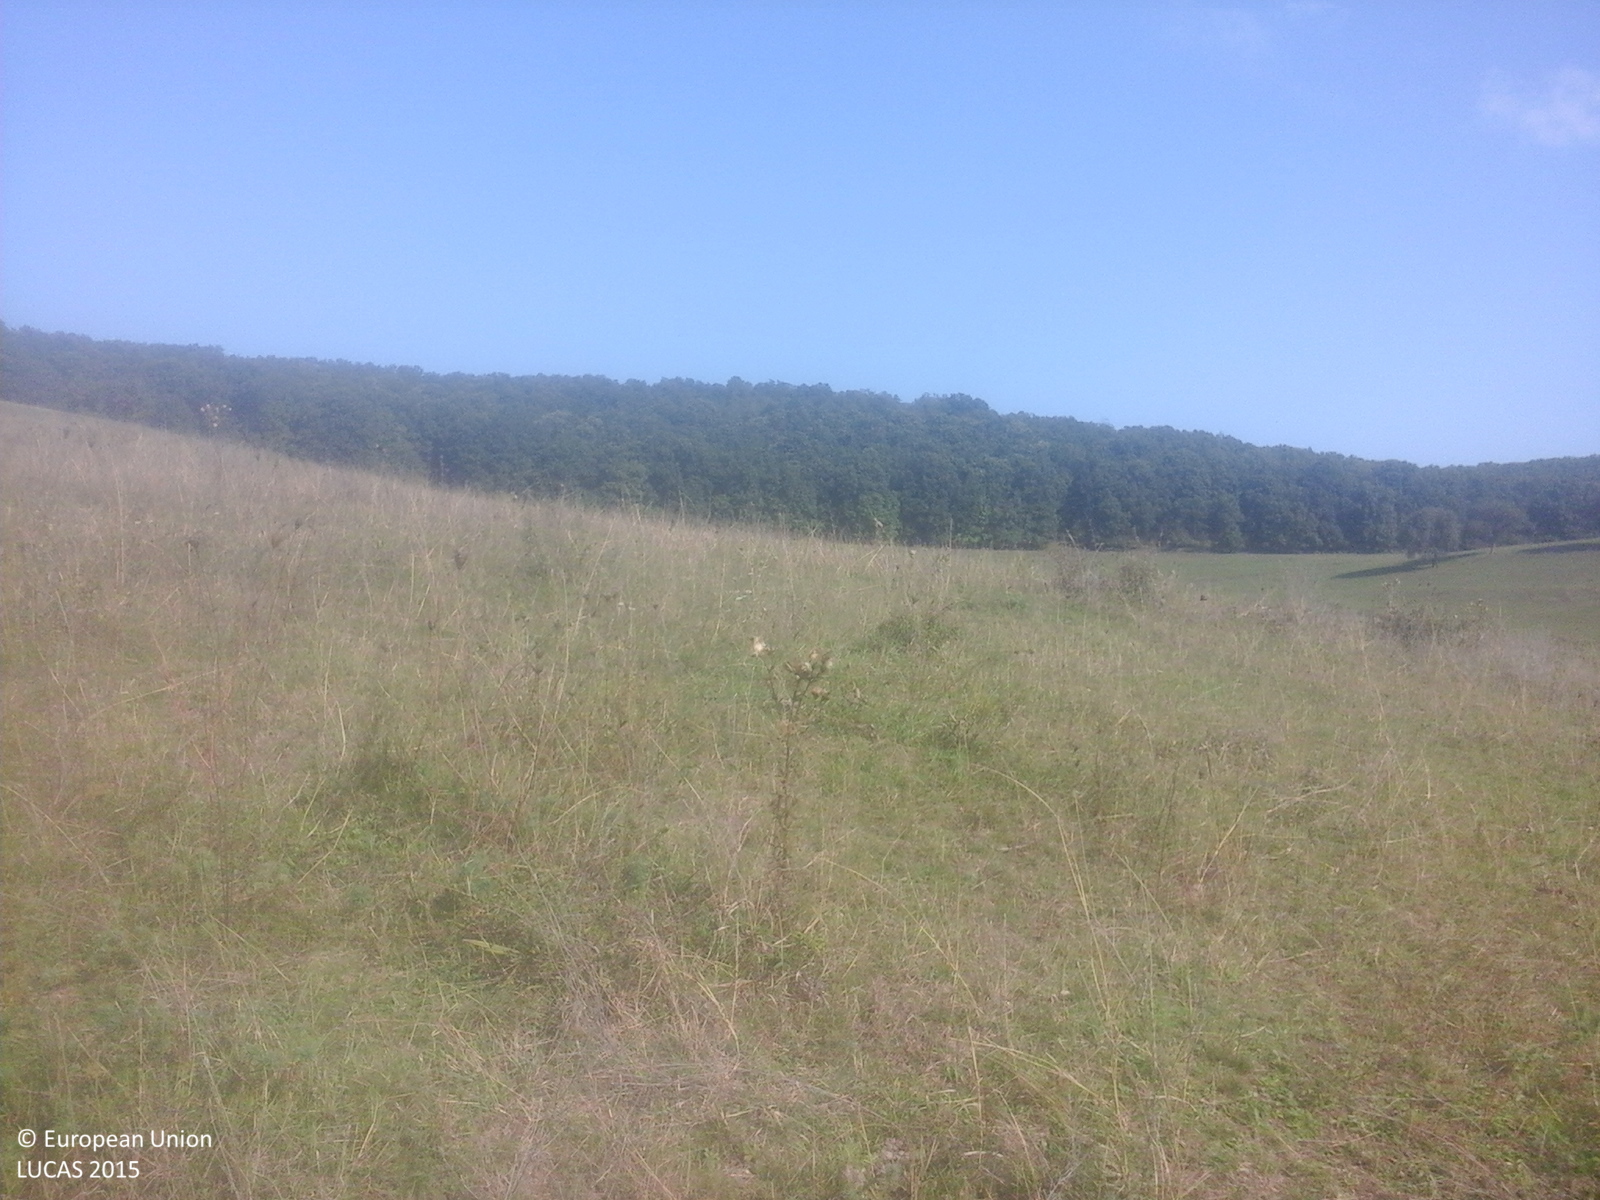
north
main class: Grassland
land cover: Grassland with sparse tree/shrub cover
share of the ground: > 75 %
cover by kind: herbaceous plants 85 %, shrubs 10 %, broadleaved forest trees 5 %
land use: Agriculture (excluding fallow land and kitchen gardens)
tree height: < 5 m
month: October
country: RO
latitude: 45.9547
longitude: 23.8627
